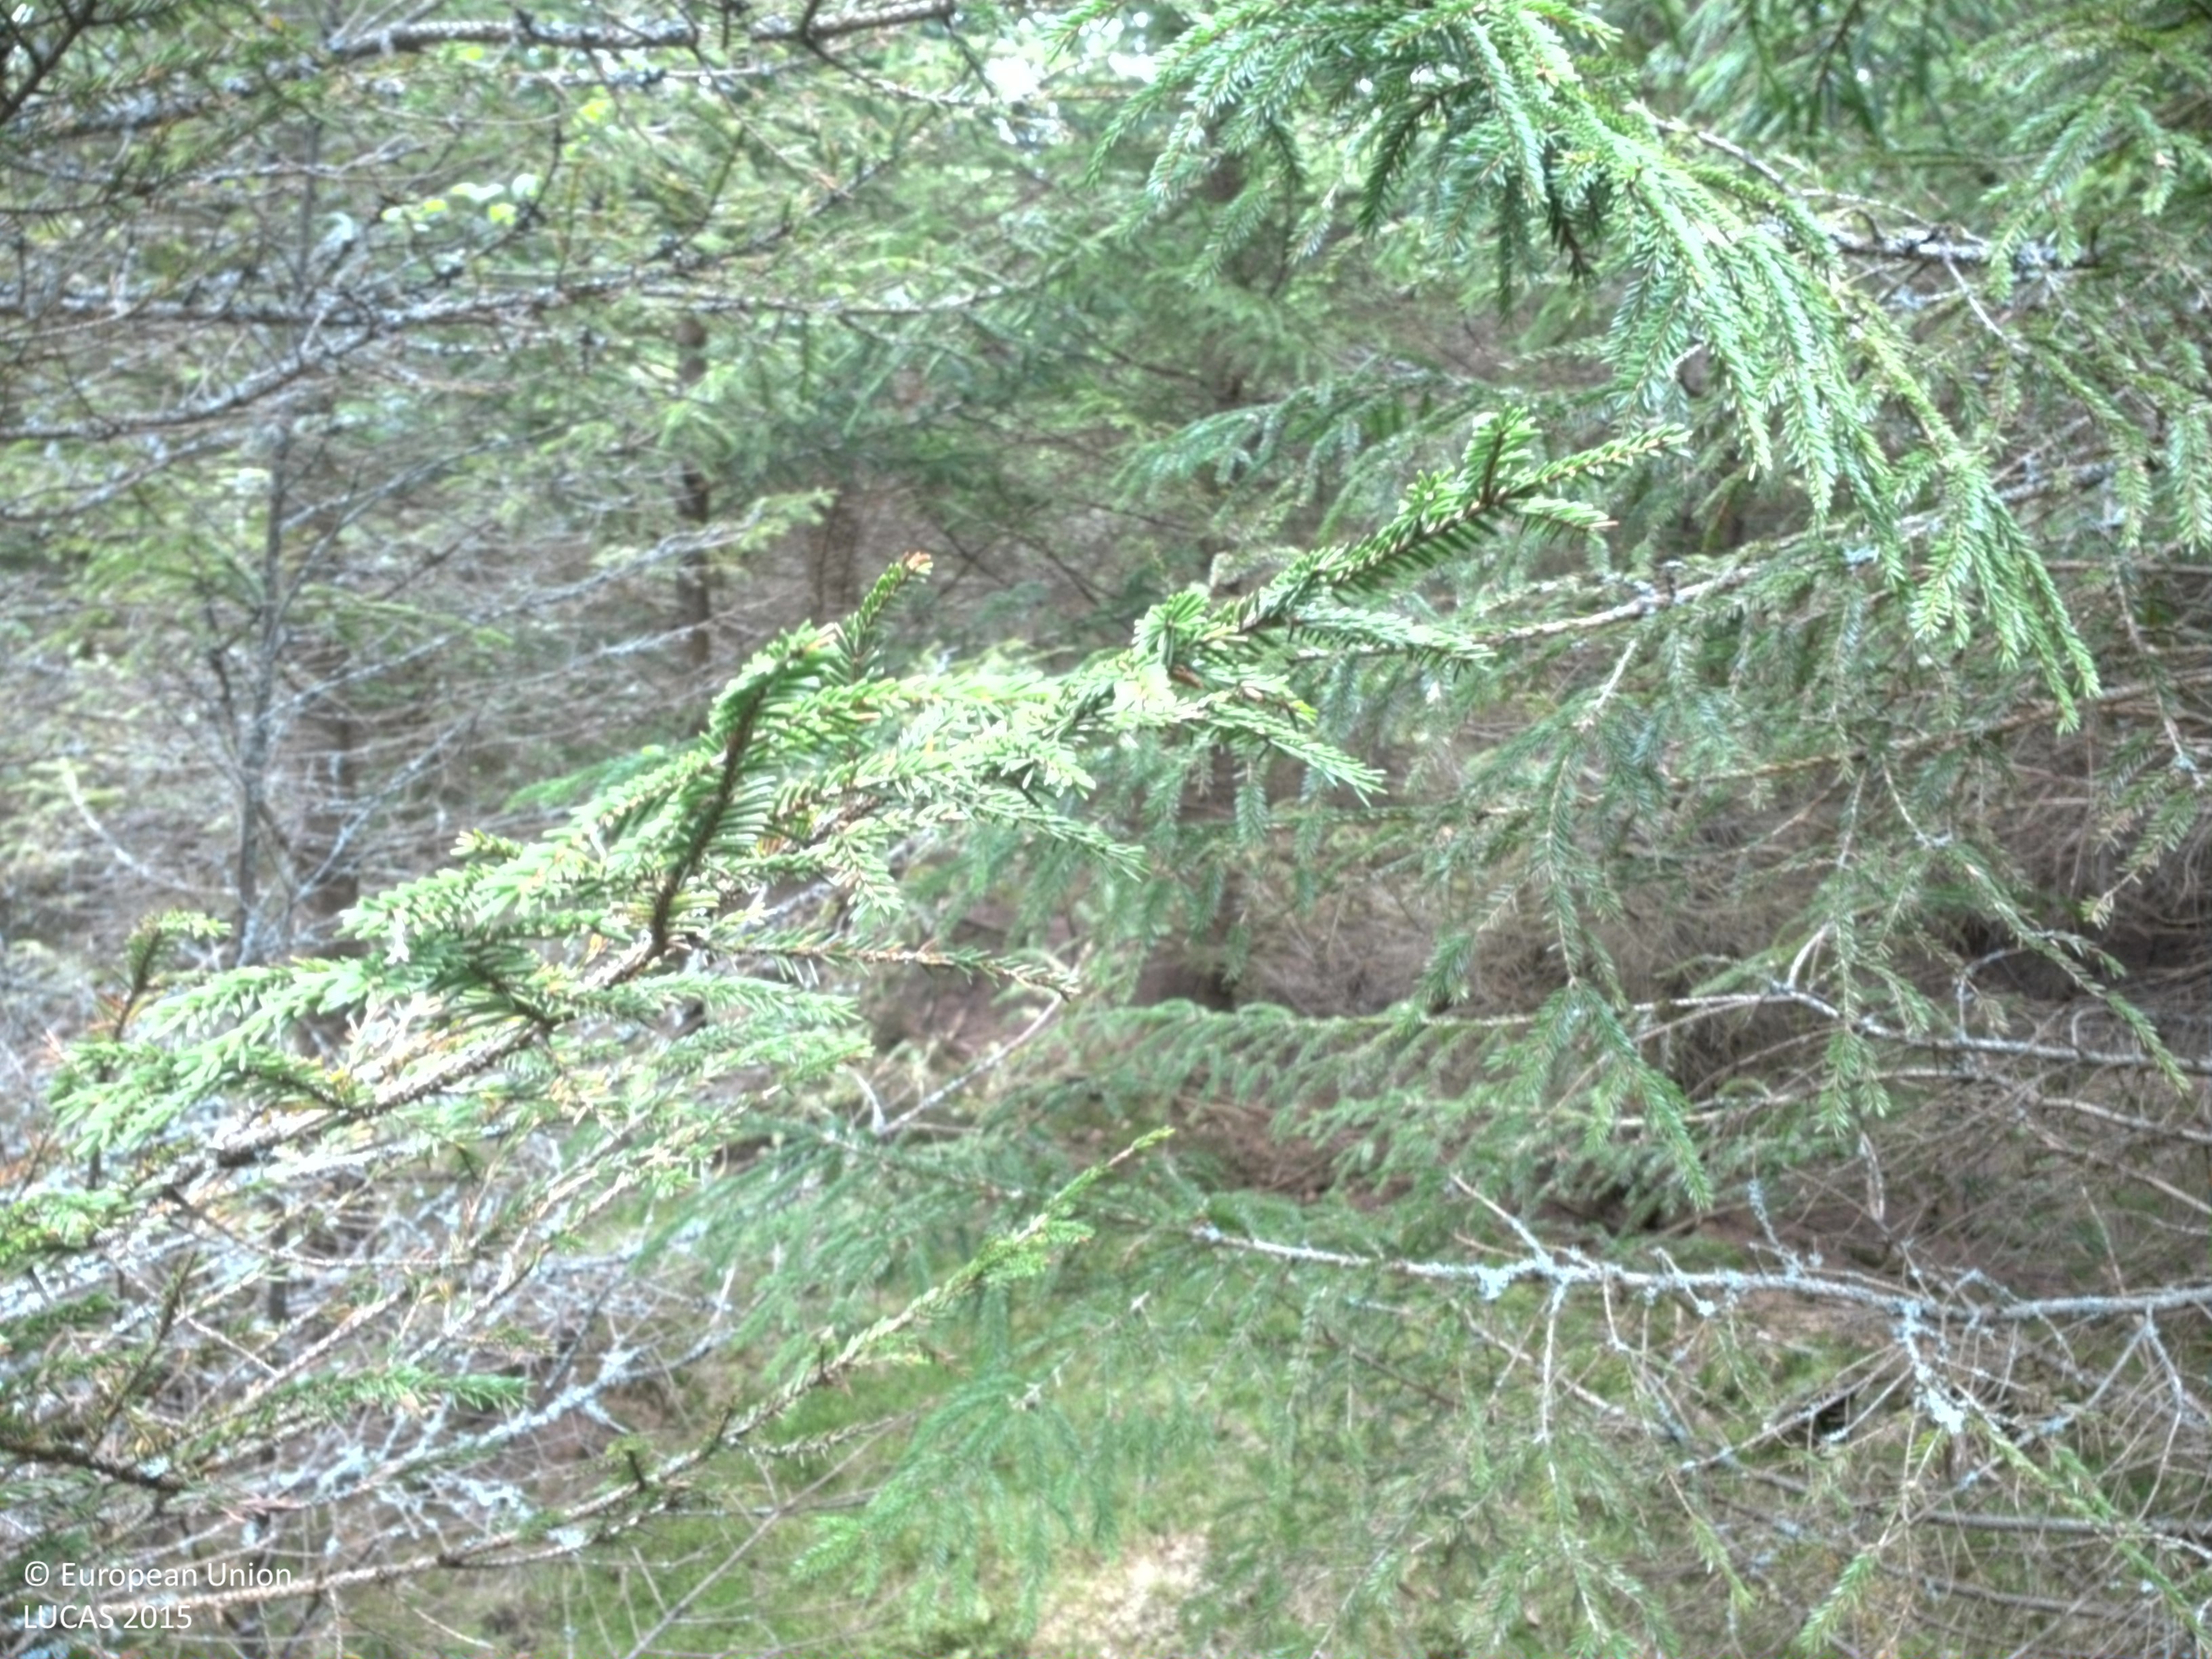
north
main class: Woodland
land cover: Spruce dominated coniferous woodland
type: boreal forest
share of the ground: > 75 %
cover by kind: coniferous forest trees 85 %, lichens and mosses 10 %, herbaceous plants 5 %
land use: Forestry
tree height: > 5 m
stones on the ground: < 10 %
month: May
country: SE
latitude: 56.6244
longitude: 15.1648
